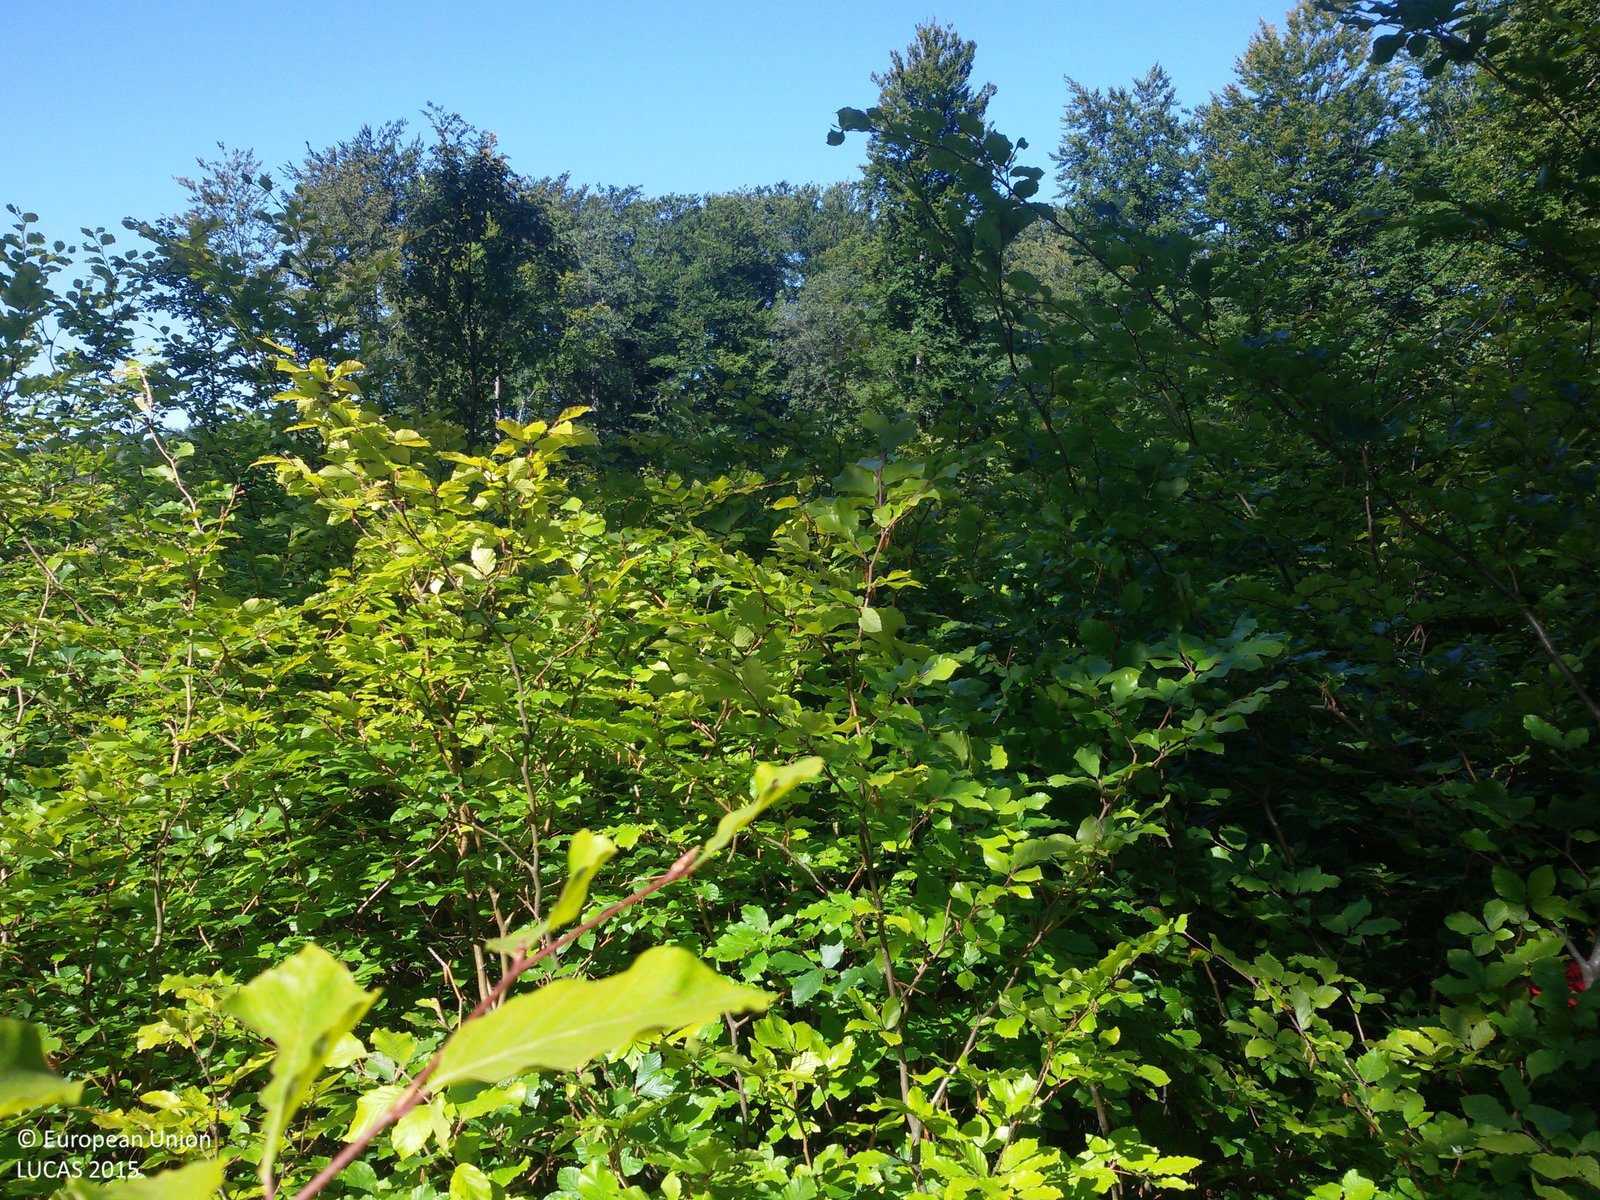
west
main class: Woodland
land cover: Broadleaved woodland
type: mesophytic deciduous forest
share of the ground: > 75 %
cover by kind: broadleaved forest trees 80 %, shrubs 15 %, herbaceous plants 5 %
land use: Forestry
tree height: > 5 m
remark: Nursery
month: August
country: PL
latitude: 54.1252
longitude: 17.2165
